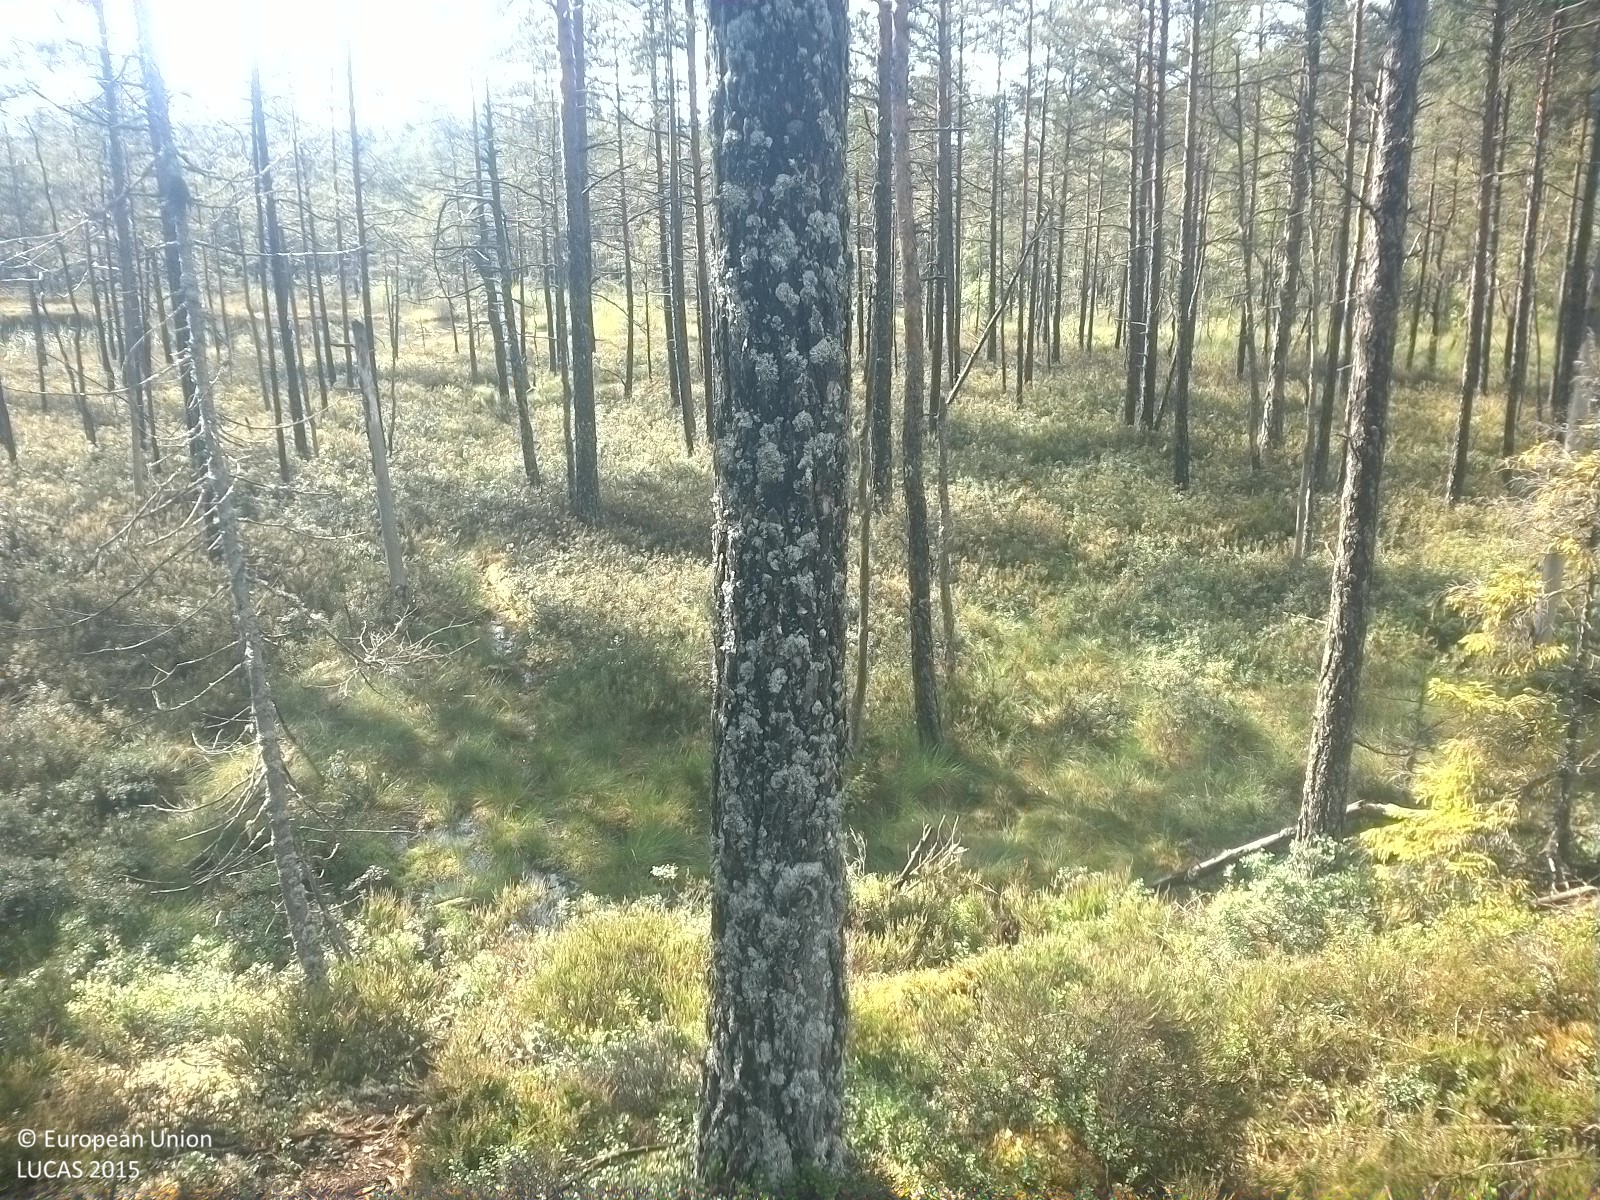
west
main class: Woodland
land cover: Pine dominated coniferous woodland
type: boreal forest
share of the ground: 25 - 50 %
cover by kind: coniferous forest trees 30 %, shrubs 30 %, herbaceous plants 20 %, lichens and mosses 20 %
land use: Forestry
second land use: Amenities, museums, leisure
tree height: > 5 m
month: July
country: SE
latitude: 58.8809
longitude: 15.0755
